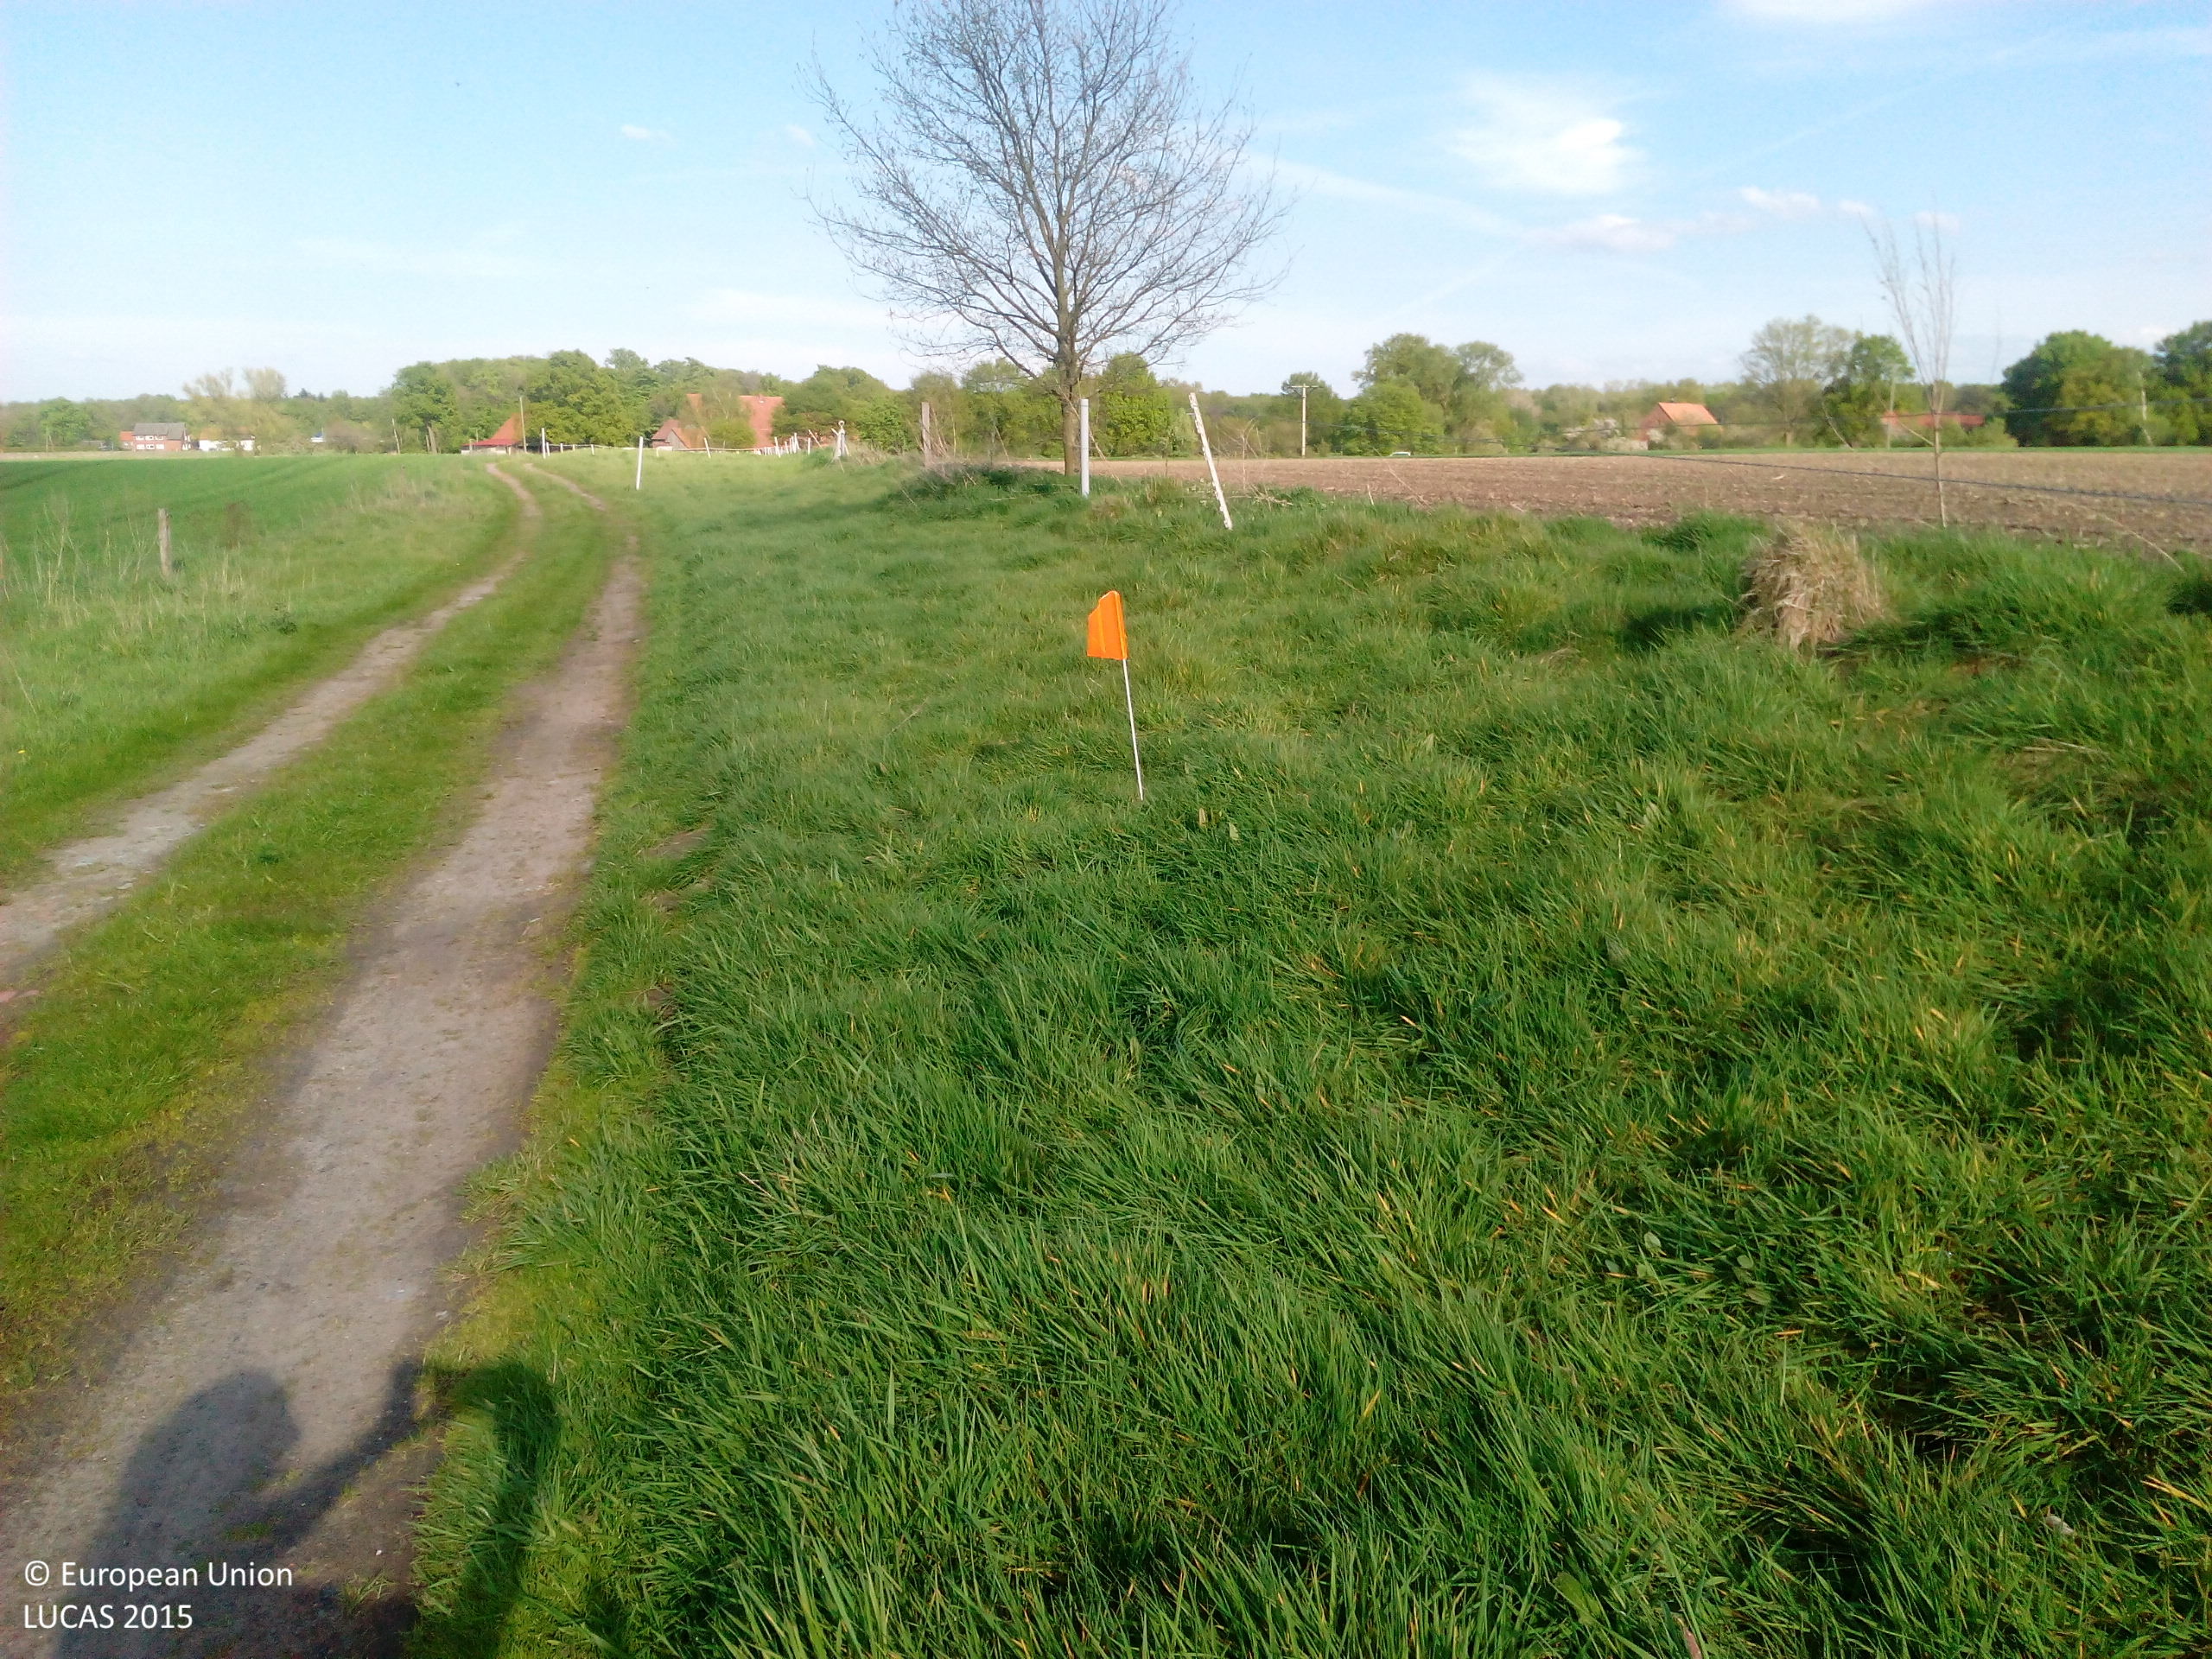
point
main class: Grassland
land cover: Grassland without tree/shrub cover
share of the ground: > 75 %
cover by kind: herbaceous plants 100 %
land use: Agriculture (excluding fallow land and kitchen gardens)
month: May
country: DE
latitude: 51.7390
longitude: 7.4660
